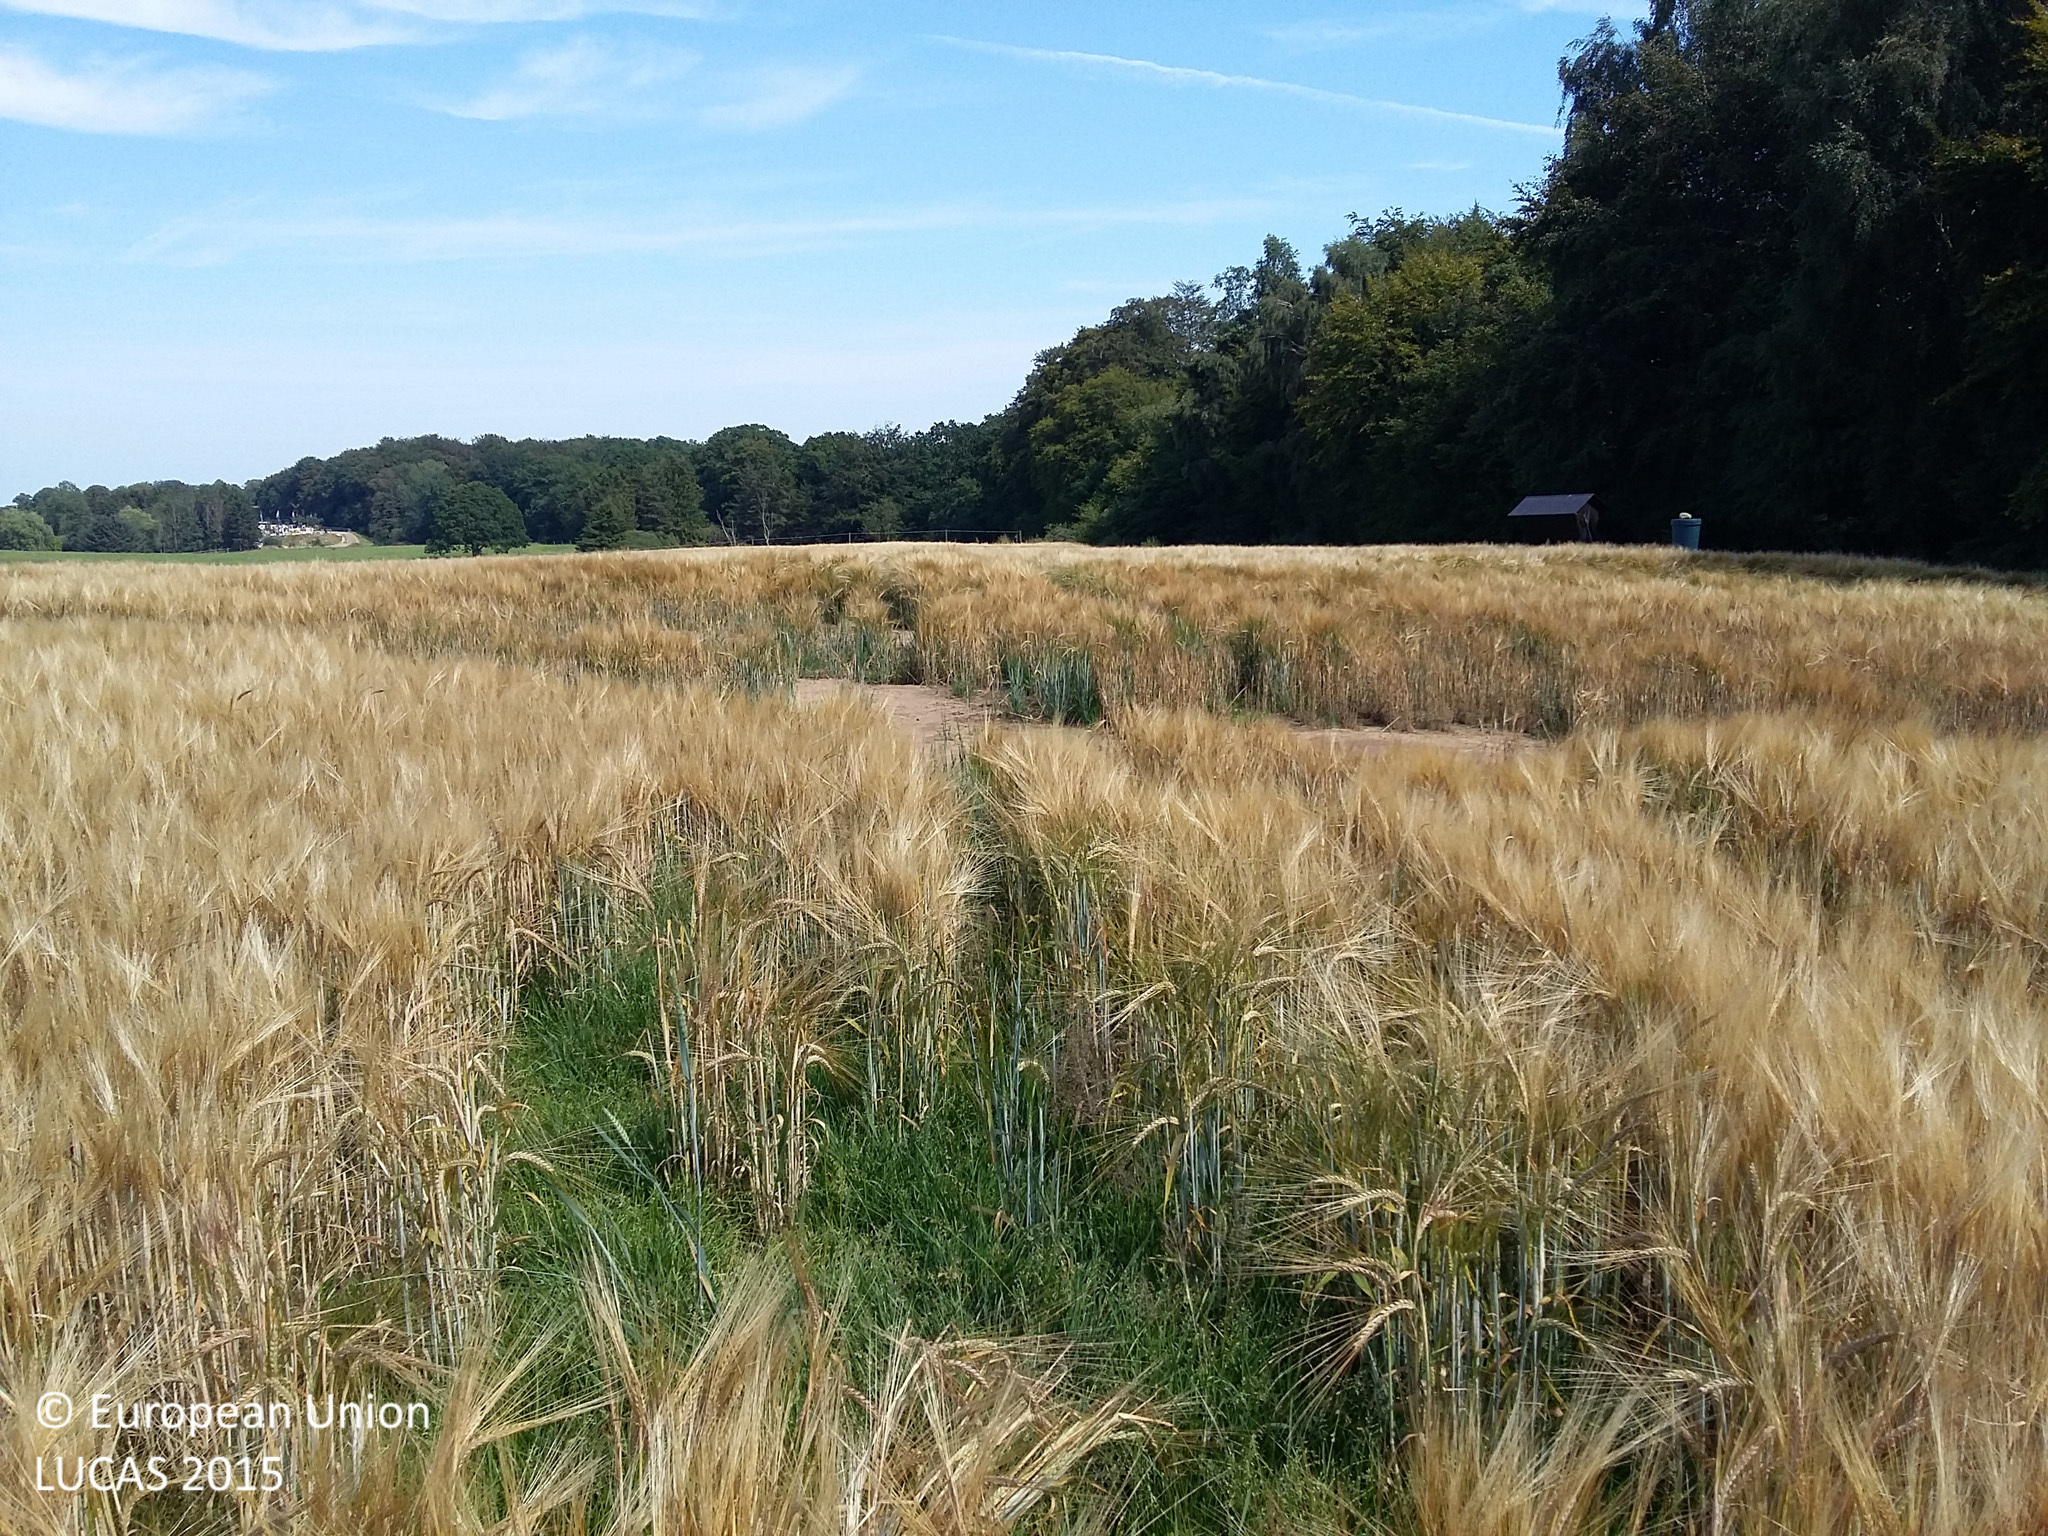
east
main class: Cropland
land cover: Barley
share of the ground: > 75 %
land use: Agriculture (excluding fallow land and kitchen gardens)
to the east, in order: Barley; Grass margins; Fences; Grassland without tree/shrub cover; Fences; Grassland without tree/shrub cover; Fences; Grassland without tree/shrub cover
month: August
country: DK
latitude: 55.3484
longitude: 11.7806
